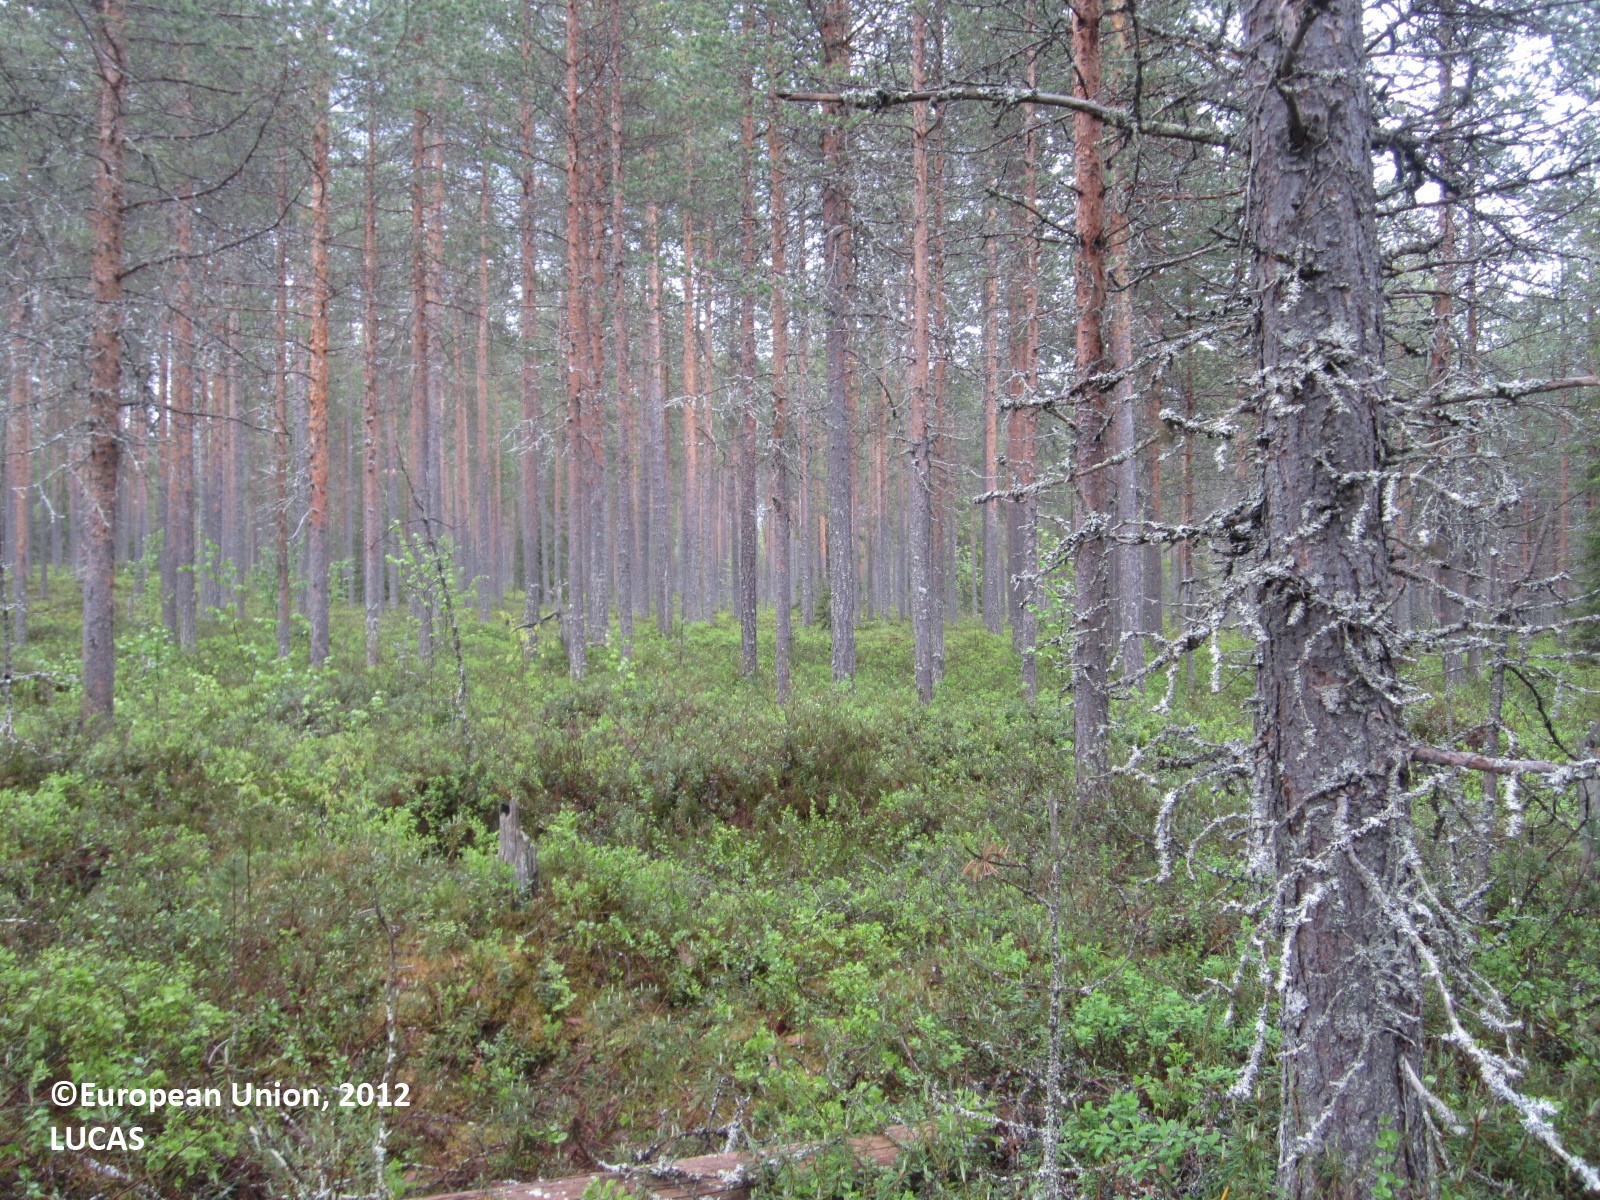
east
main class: Woodland
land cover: Pine dominated coniferous woodland
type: boreal forest
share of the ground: > 75 %
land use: Forestry
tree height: > 5 m
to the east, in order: Pine dominated coniferous woodland; Ditches and canals; Pine dominated coniferous woodland; Shrubland with sparse tree cover; Pine dominated coniferous woodland
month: June
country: FI
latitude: 64.8153
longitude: 29.2162
